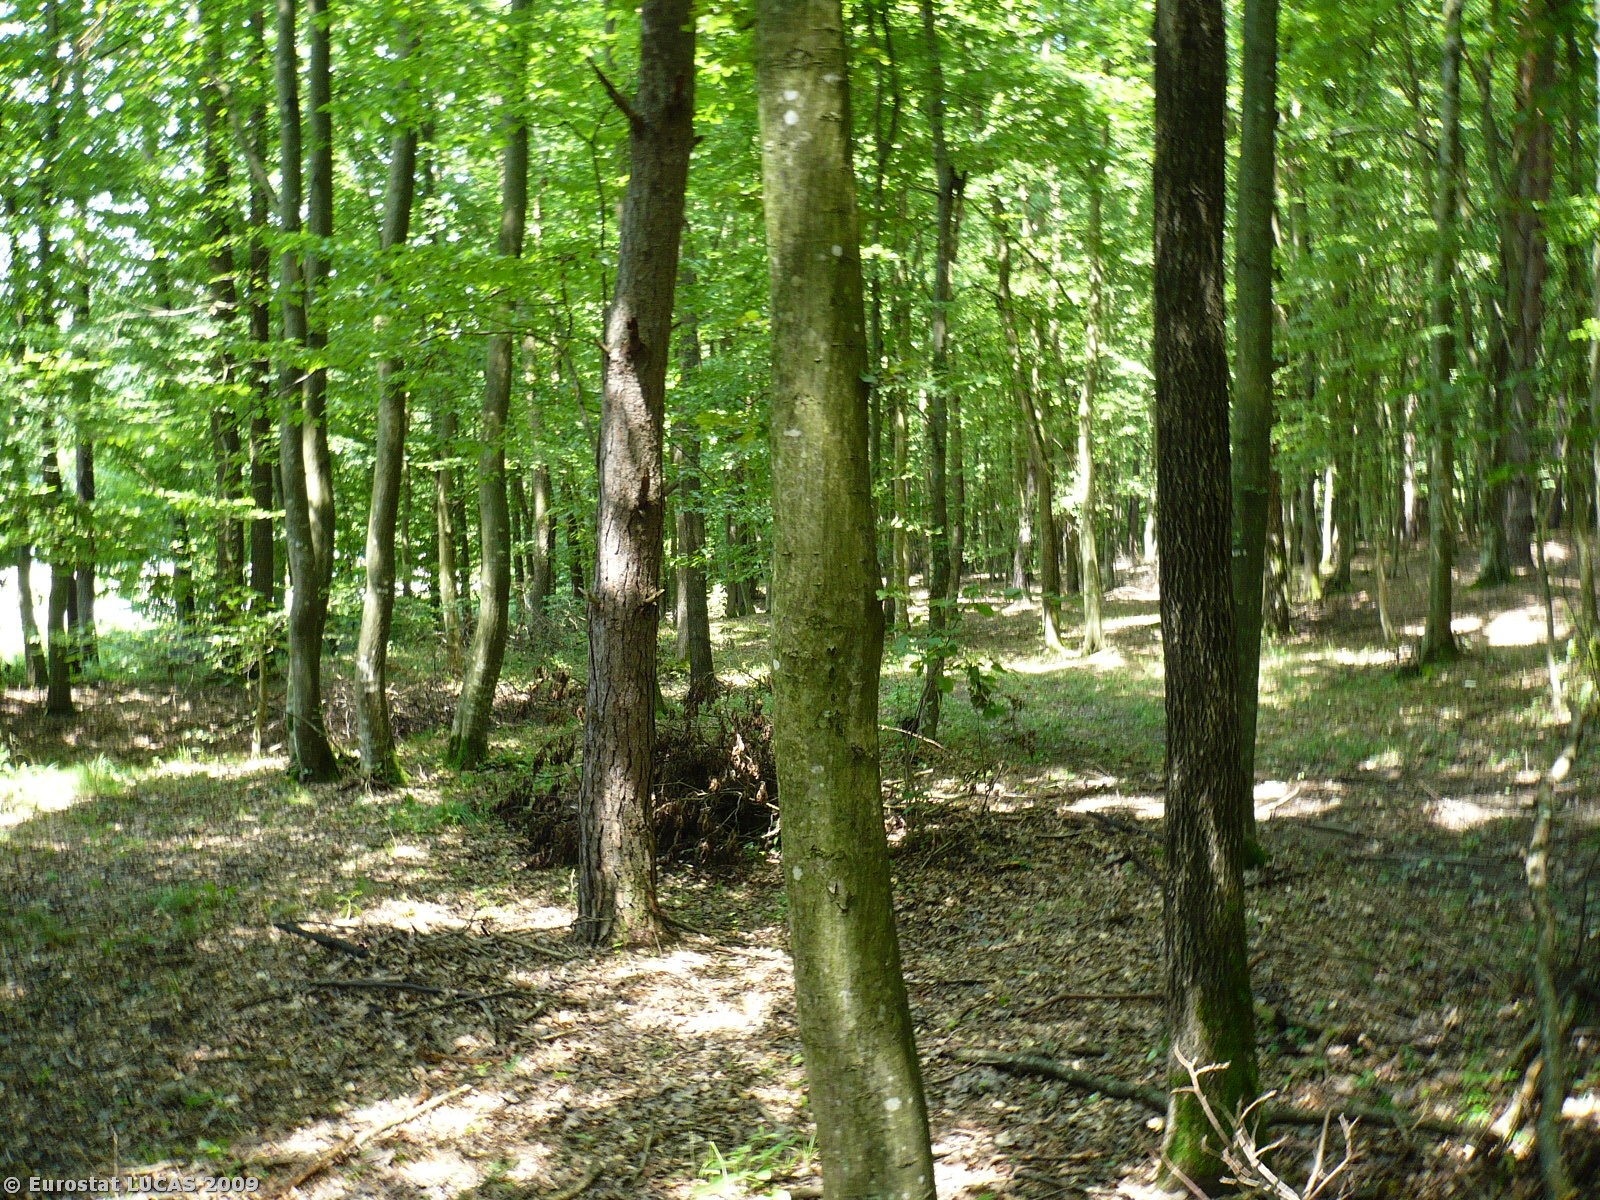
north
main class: Woodland
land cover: Broadleaved woodland
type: mesophytic deciduous forest
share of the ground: > 75 %
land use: Forestry
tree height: > 5 m
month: July
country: SI
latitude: 46.6688
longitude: 16.3404
